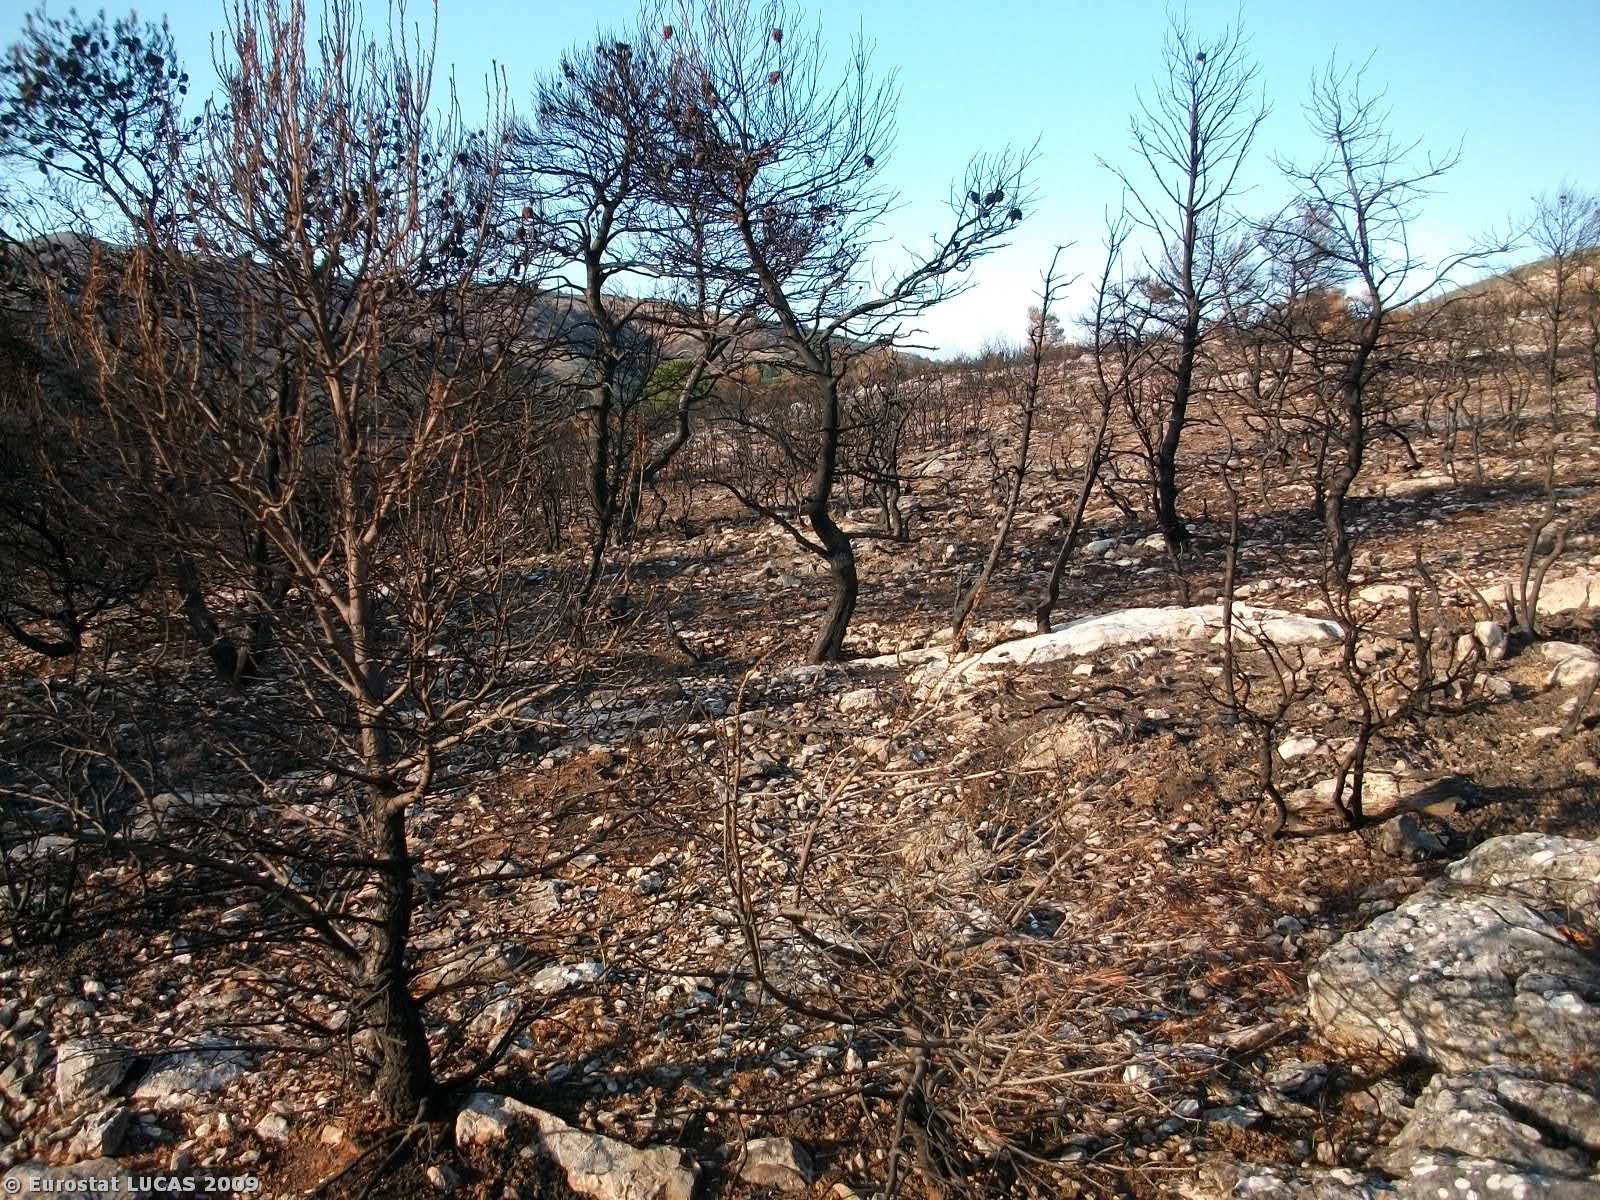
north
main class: Woodland
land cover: Mixed woodland
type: non-riverine alder, birch or aspen forest
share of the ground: < 10 %
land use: Forestry
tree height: > 5 m
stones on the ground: 25 - 50 %
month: September
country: GR
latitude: 38.1945
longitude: 23.9968
